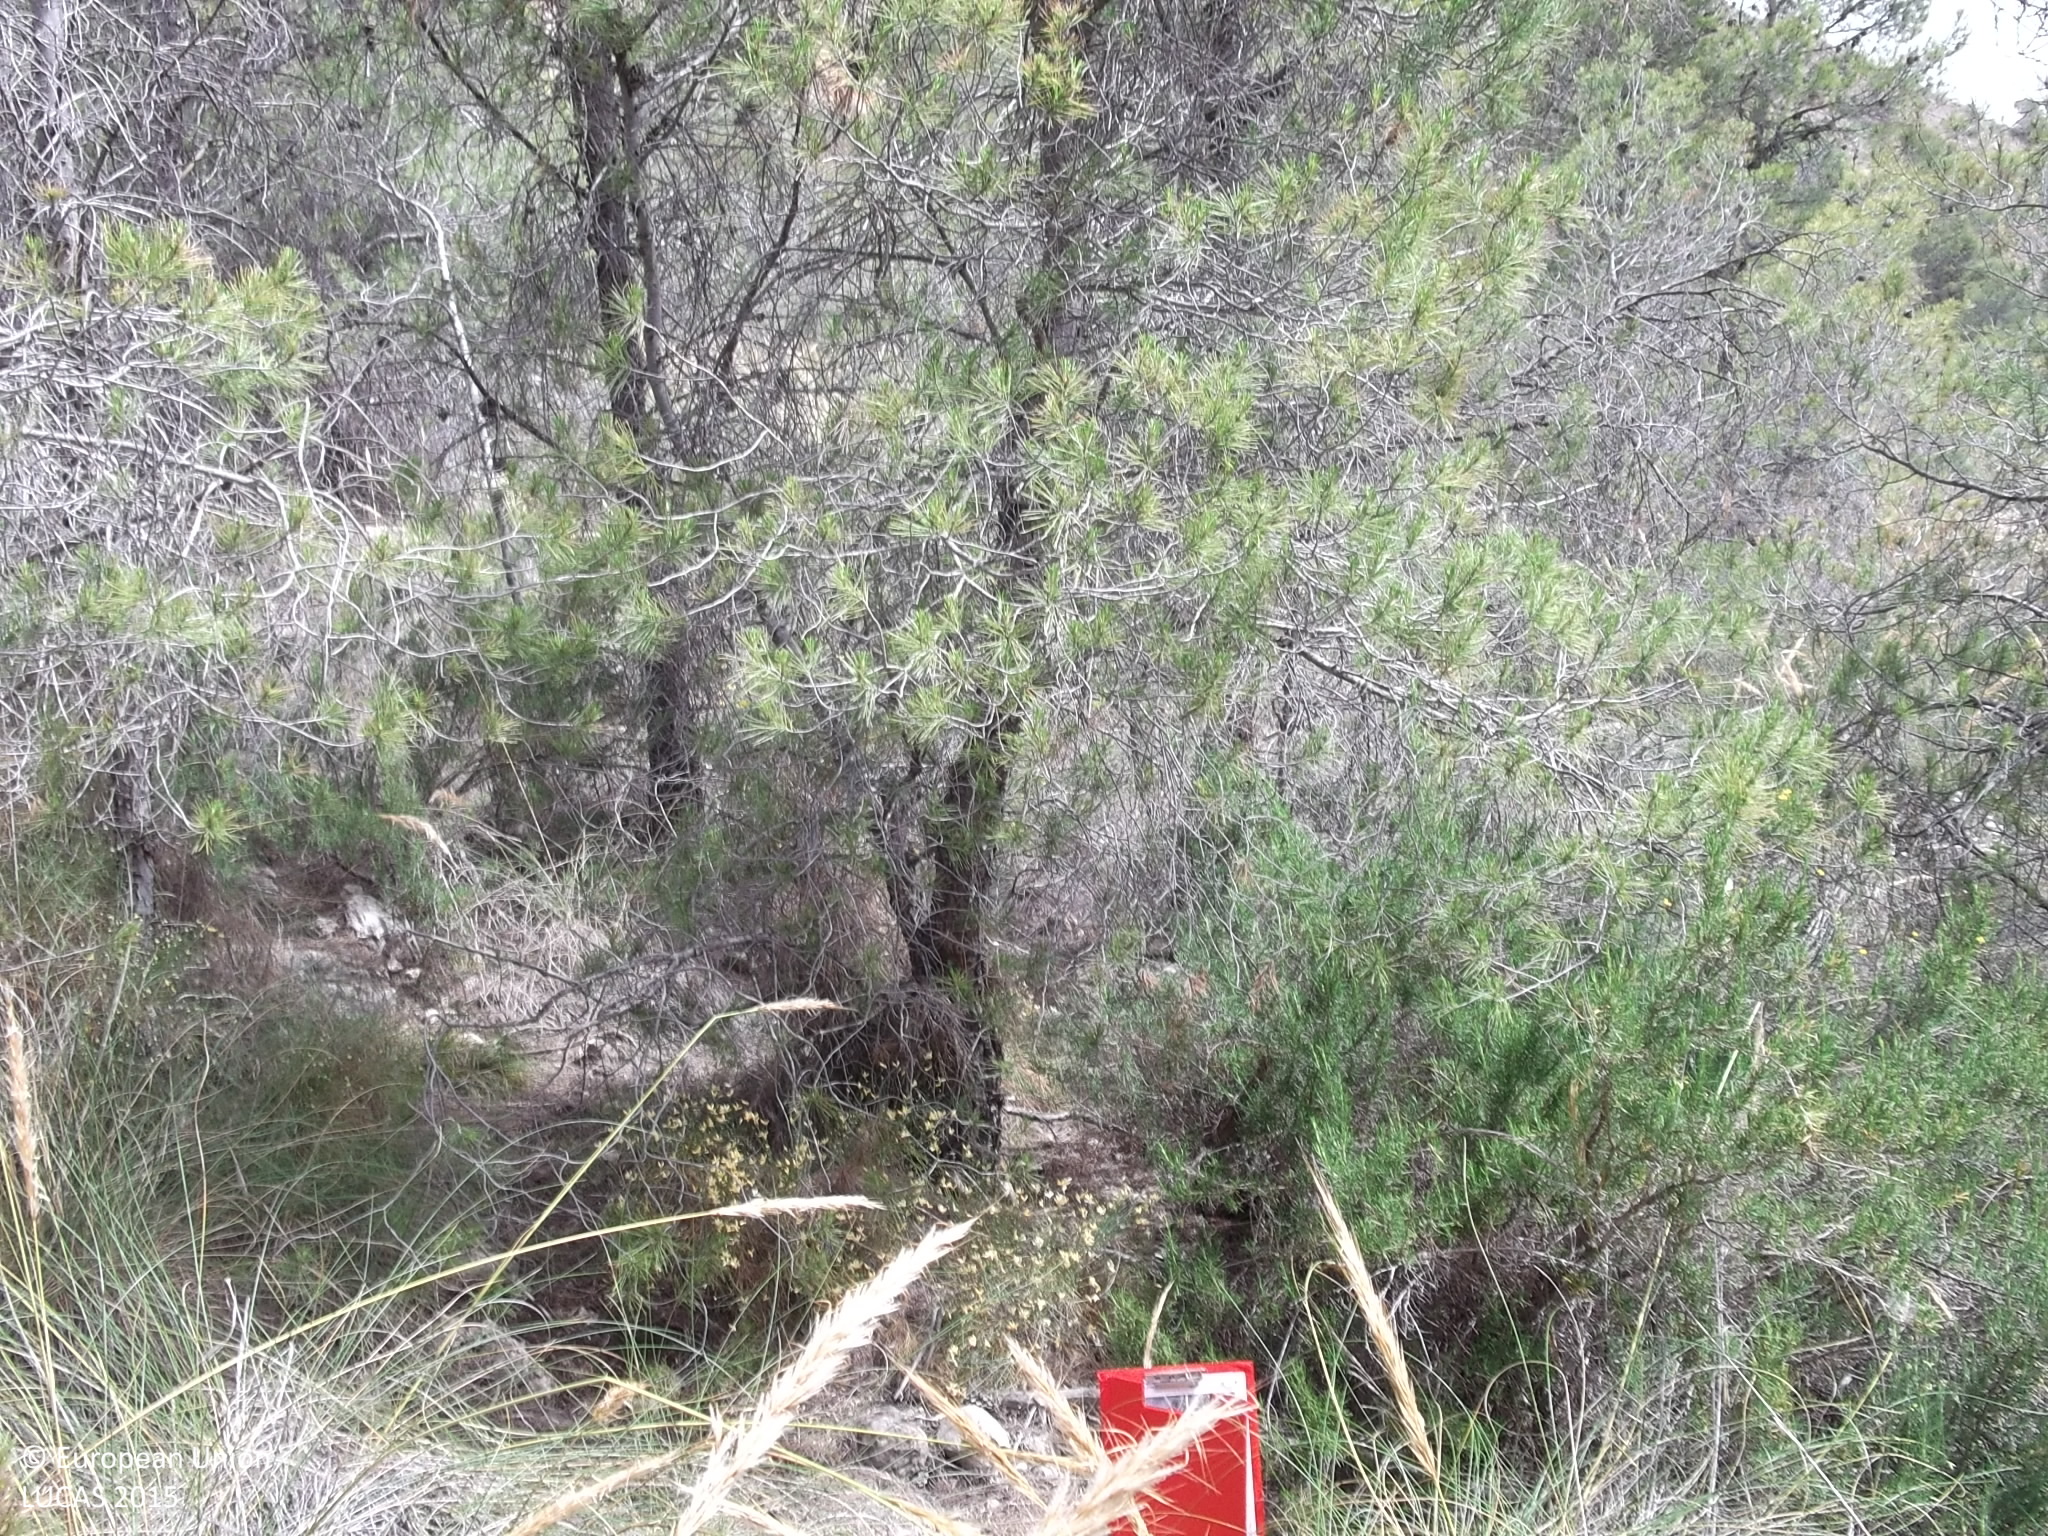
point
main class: Woodland
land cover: Pine dominated coniferous woodland
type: coniferous forest of the mediterranean region
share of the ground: 25 - 50 %
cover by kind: coniferous forest trees 35 %, shrubs 35 %, herbaceous plants 20 %, consolidated bare surface 10 %
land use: Semi-natural and natural areas not in use
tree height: > 5 m
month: May
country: ES
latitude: 38.4358
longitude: -1.6661
